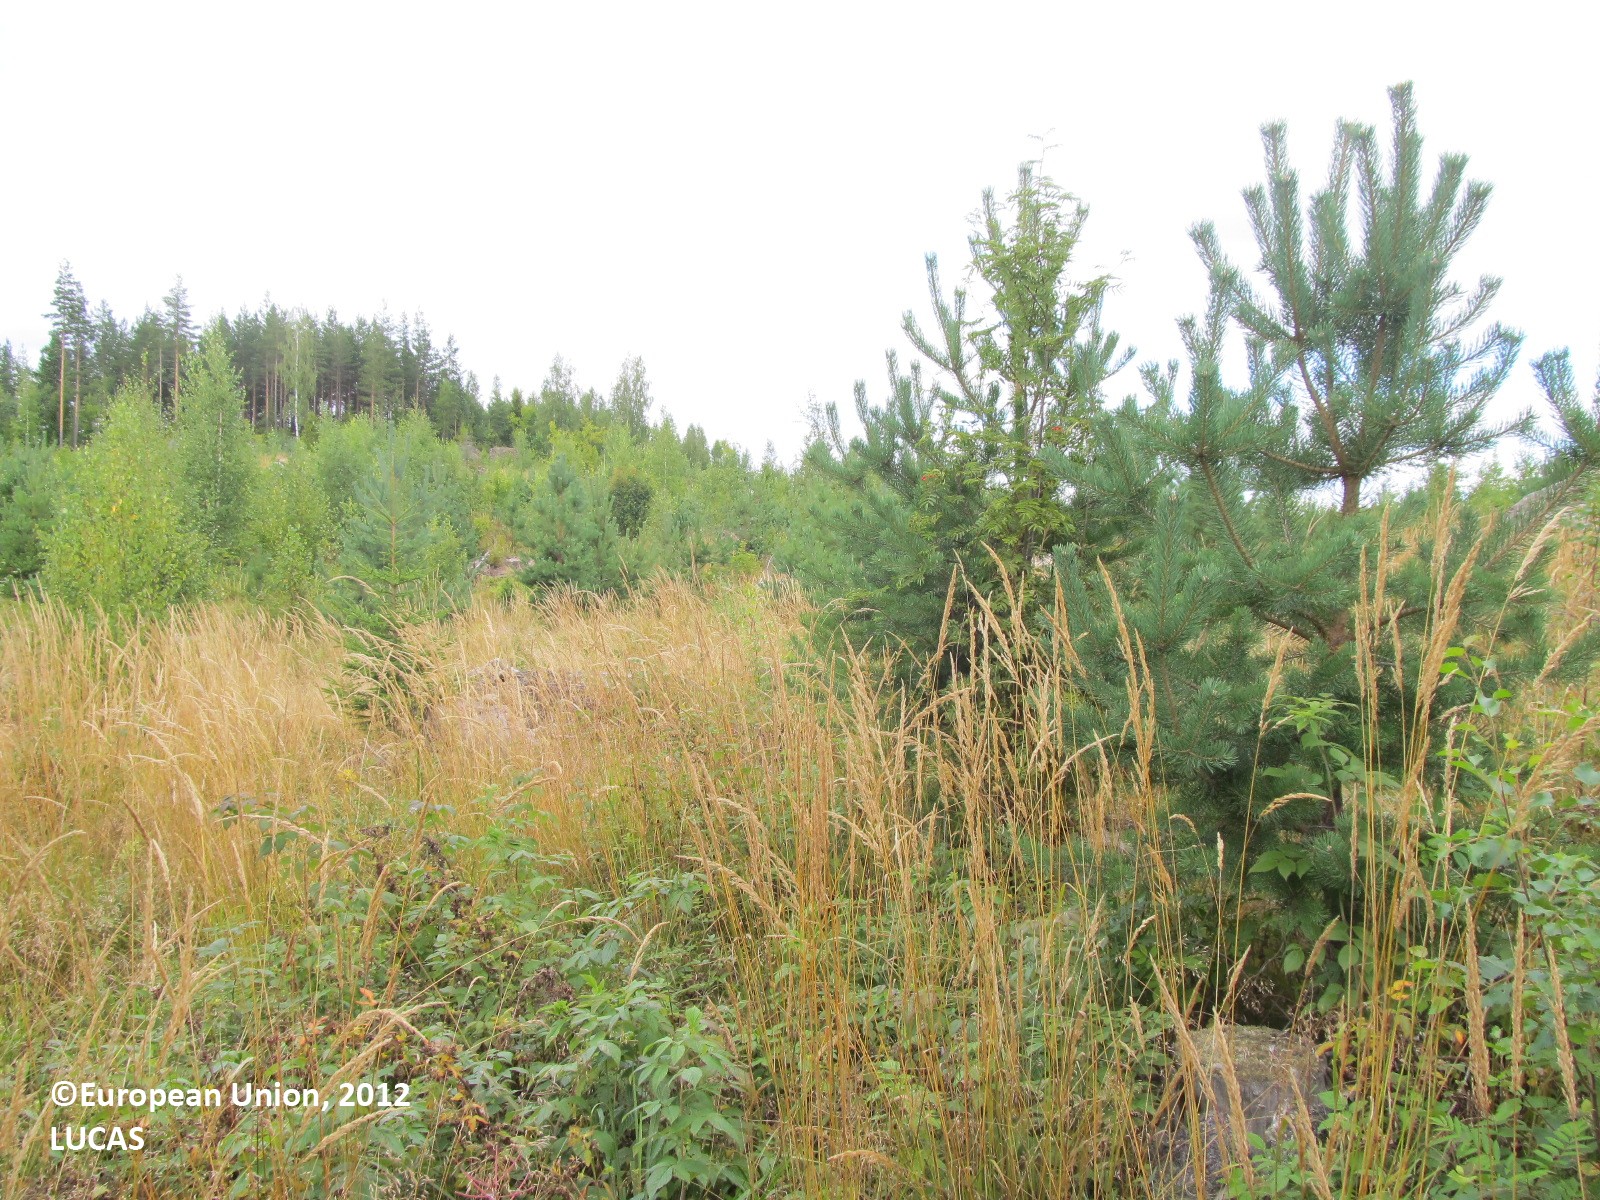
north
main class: Woodland
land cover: Spruce dominated mixed woodland
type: boreal forest
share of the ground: 25 - 50 %
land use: Forestry
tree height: < 5 m
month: August
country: FI
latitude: 61.7100
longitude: 27.7553
